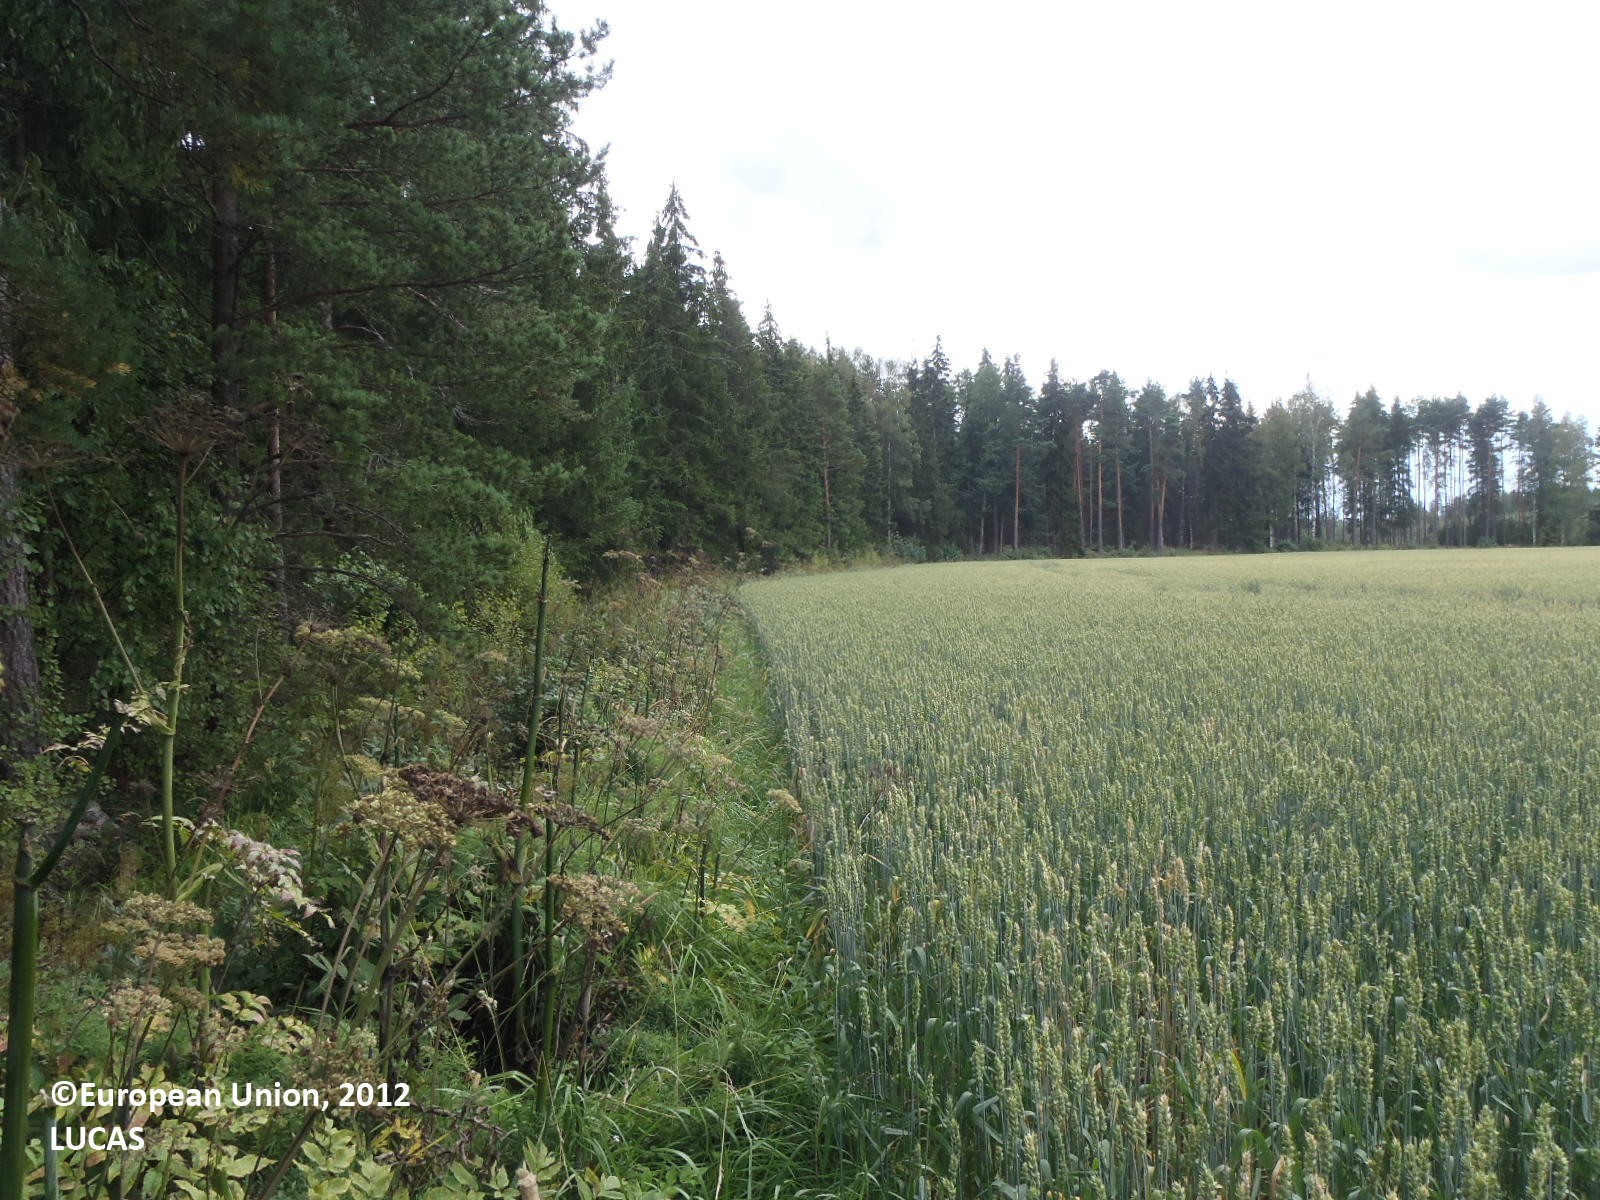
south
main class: Cropland
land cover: Barley
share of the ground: > 75 %
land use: Agriculture (excluding fallow land and kitchen gardens)
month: August
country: FI
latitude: 60.5617
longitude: 22.1951
